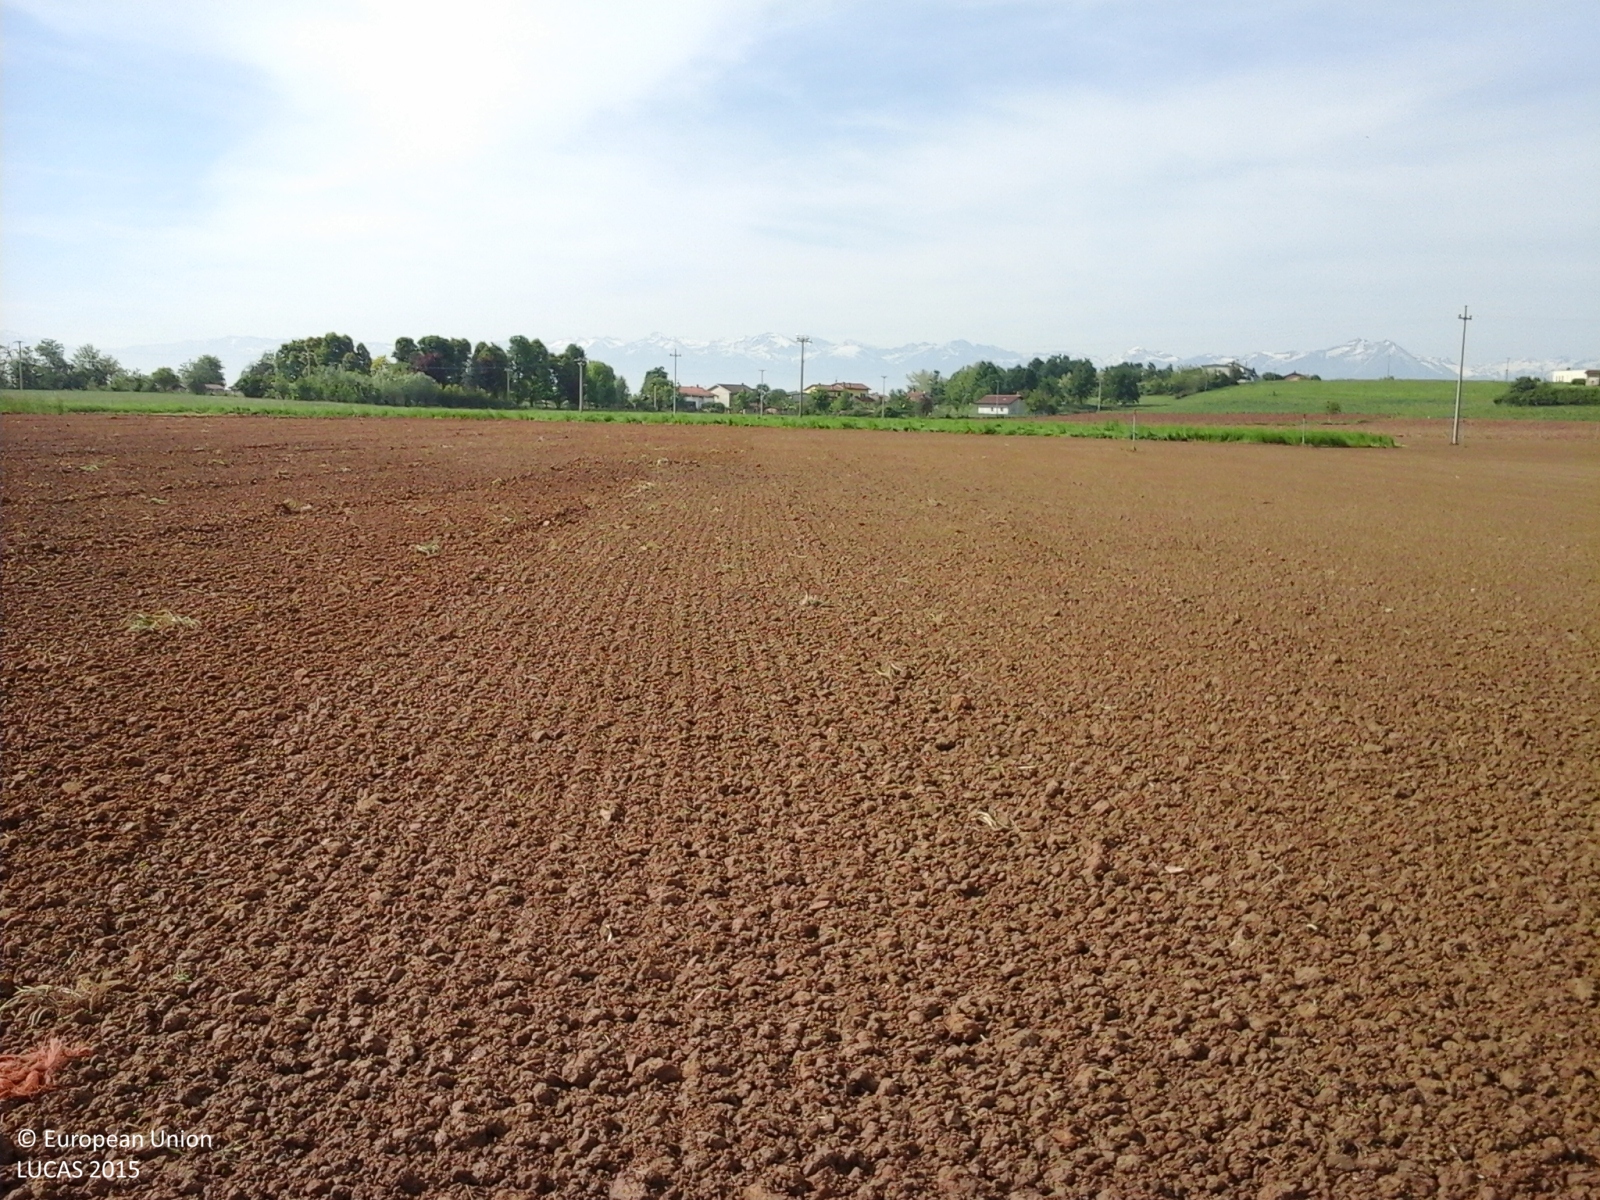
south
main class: Cropland
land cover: Maize
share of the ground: < 10 %
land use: Agriculture (excluding fallow land and kitchen gardens)
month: May
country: IT
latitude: 44.5438
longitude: 7.8019
